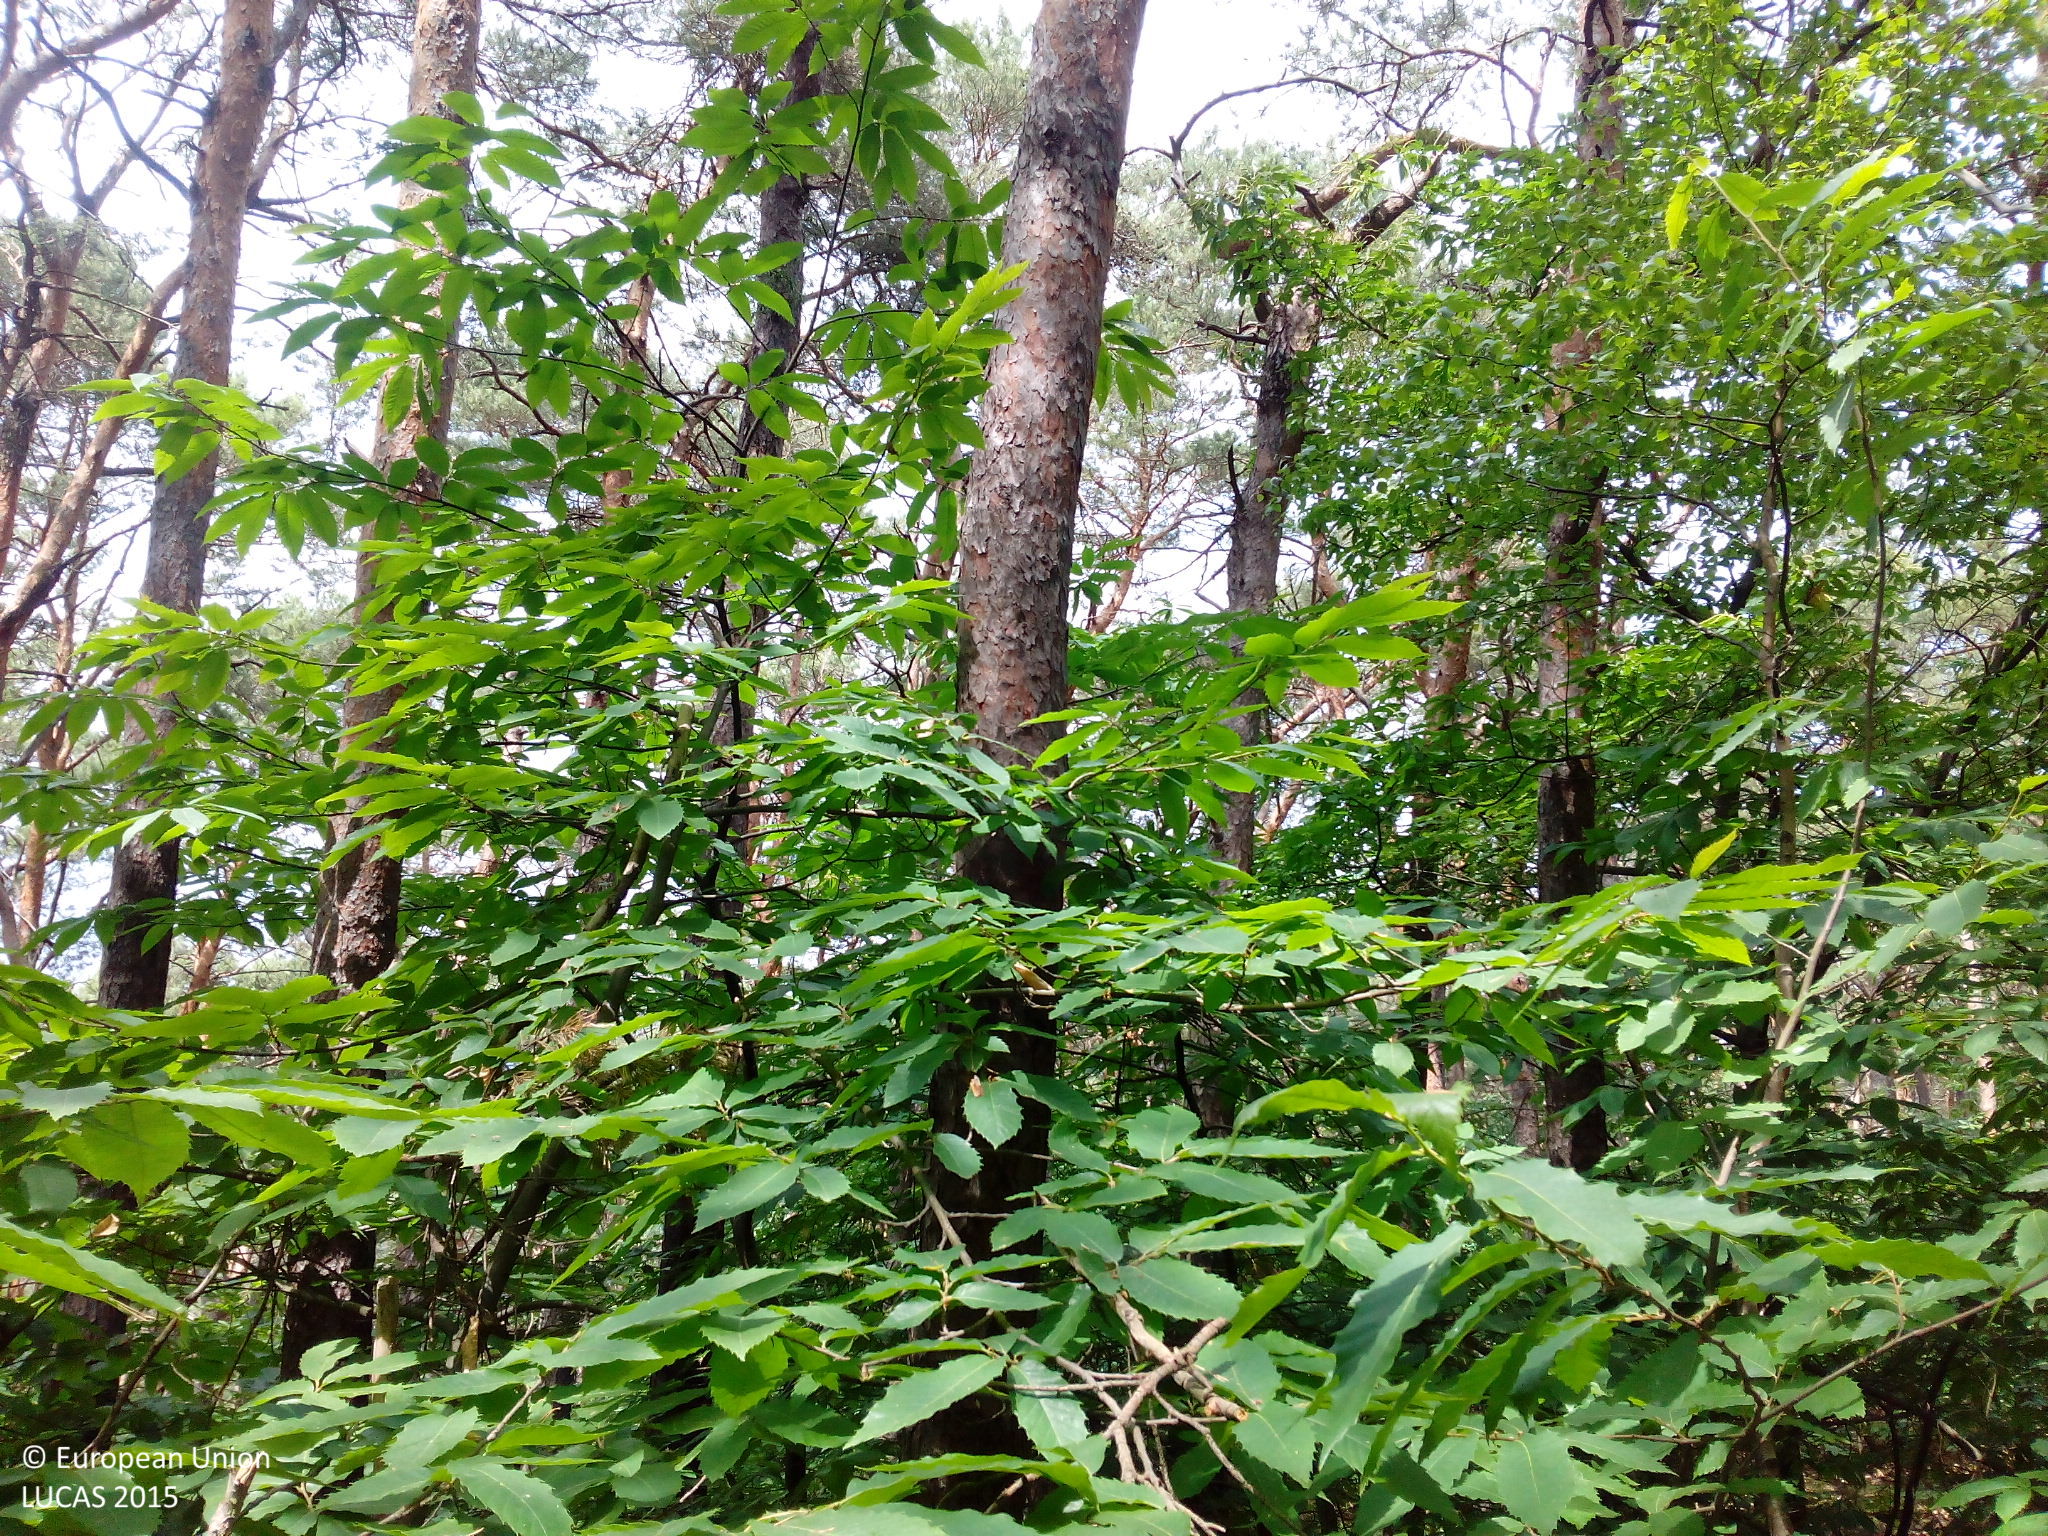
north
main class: Woodland
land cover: Pine dominated mixed woodland
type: hemiboreal forest and nemoral coniferous forest and mixed broadleaved-coniferous forest
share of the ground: > 75 %
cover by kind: coniferous forest trees 55 %, broadleaved forest trees 30 %, herbaceous plants 10 %, shrubs 5 %
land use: Forestry
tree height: > 5 m
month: June
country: DE
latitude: 49.4320
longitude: 8.1666
